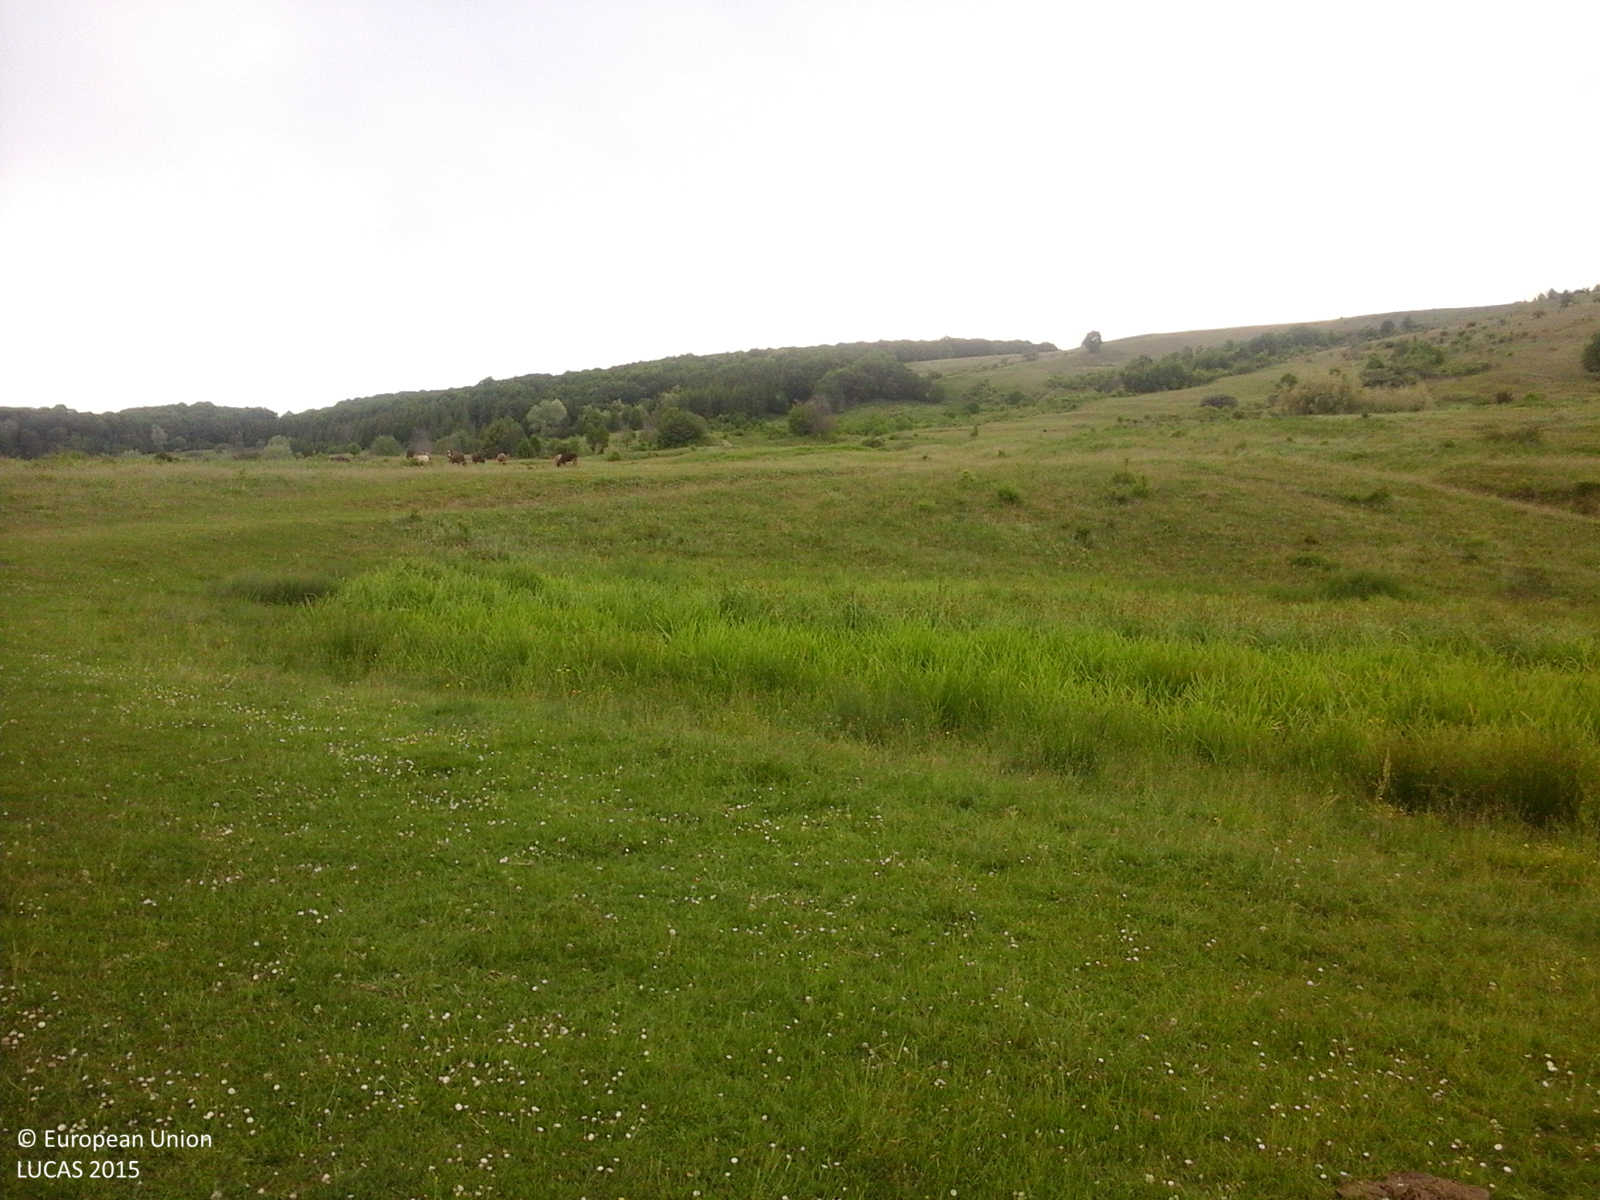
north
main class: Grassland
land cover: Grassland without tree/shrub cover
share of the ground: > 75 %
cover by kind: herbaceous plants 100 %
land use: Agriculture (excluding fallow land and kitchen gardens)
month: June
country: RO
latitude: 46.5194
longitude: 26.7877
